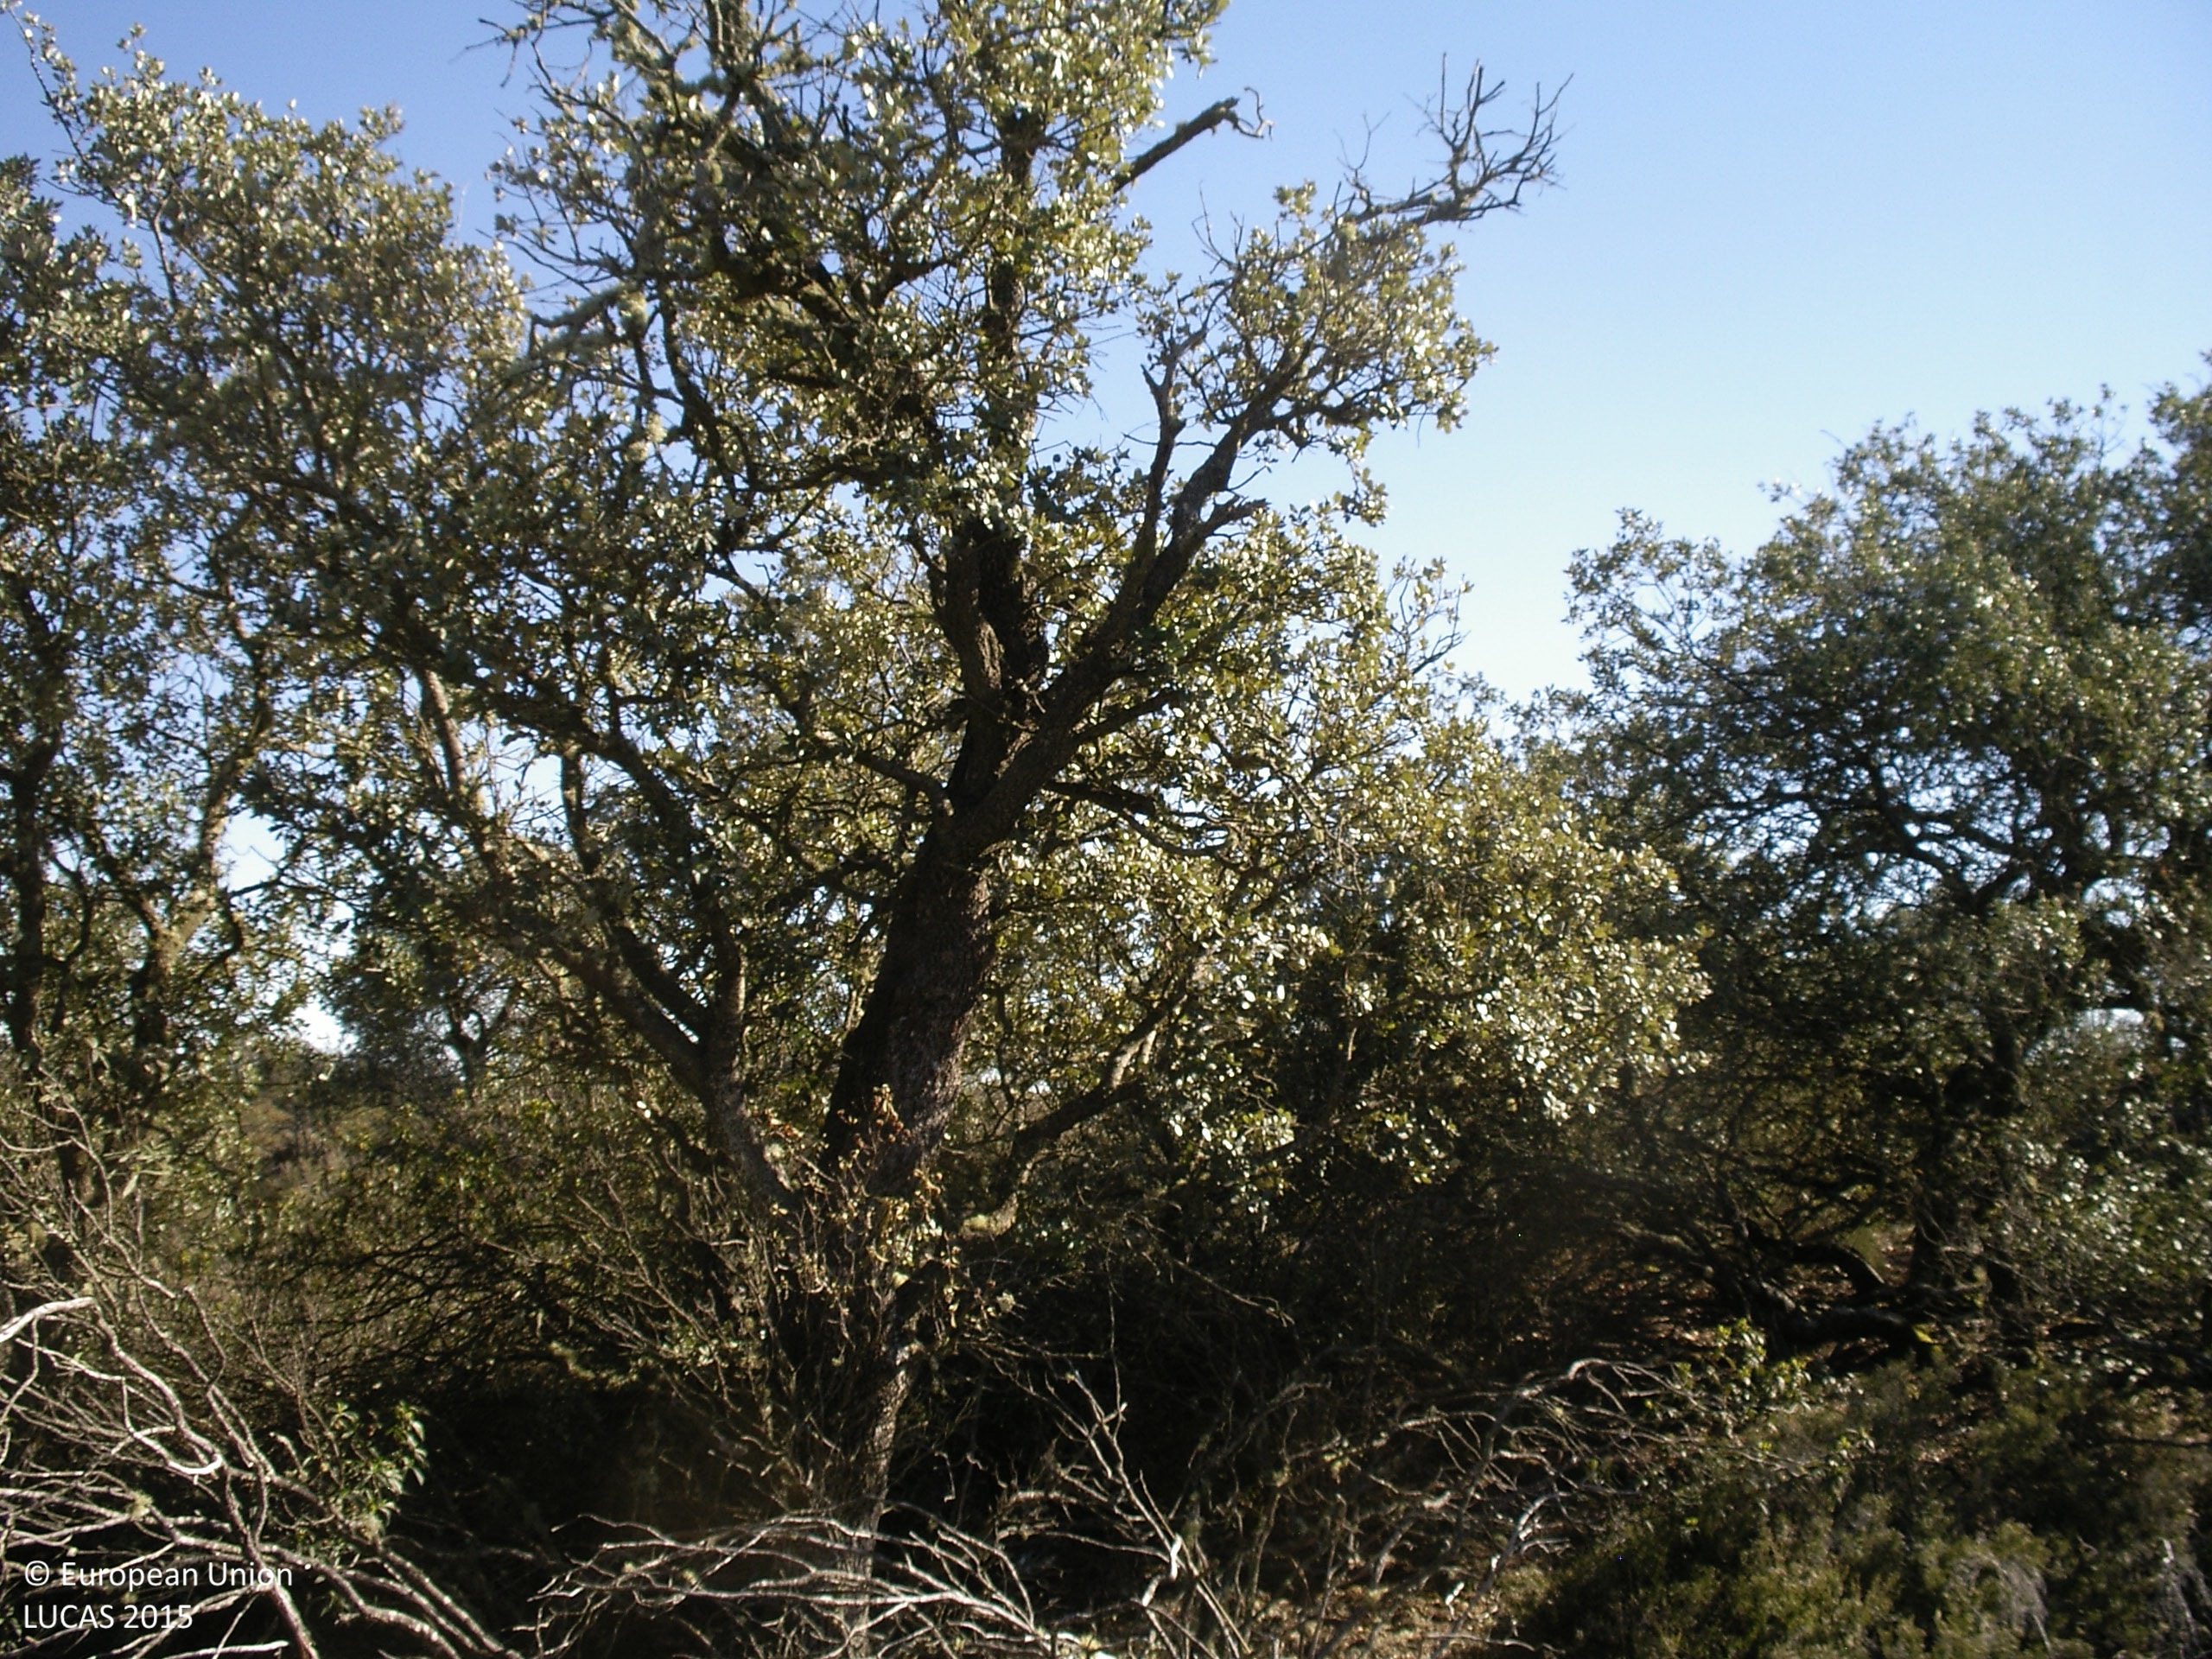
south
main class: Woodland
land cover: Broadleaved woodland
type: broadleaved evergreen forest
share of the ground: > 75 %
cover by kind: broadleaved forest trees 90 %, shrubs 10 %
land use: Forestry
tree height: > 5 m
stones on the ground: 10 - 25 %
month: March
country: ES
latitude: 42.3398
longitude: -6.0406
